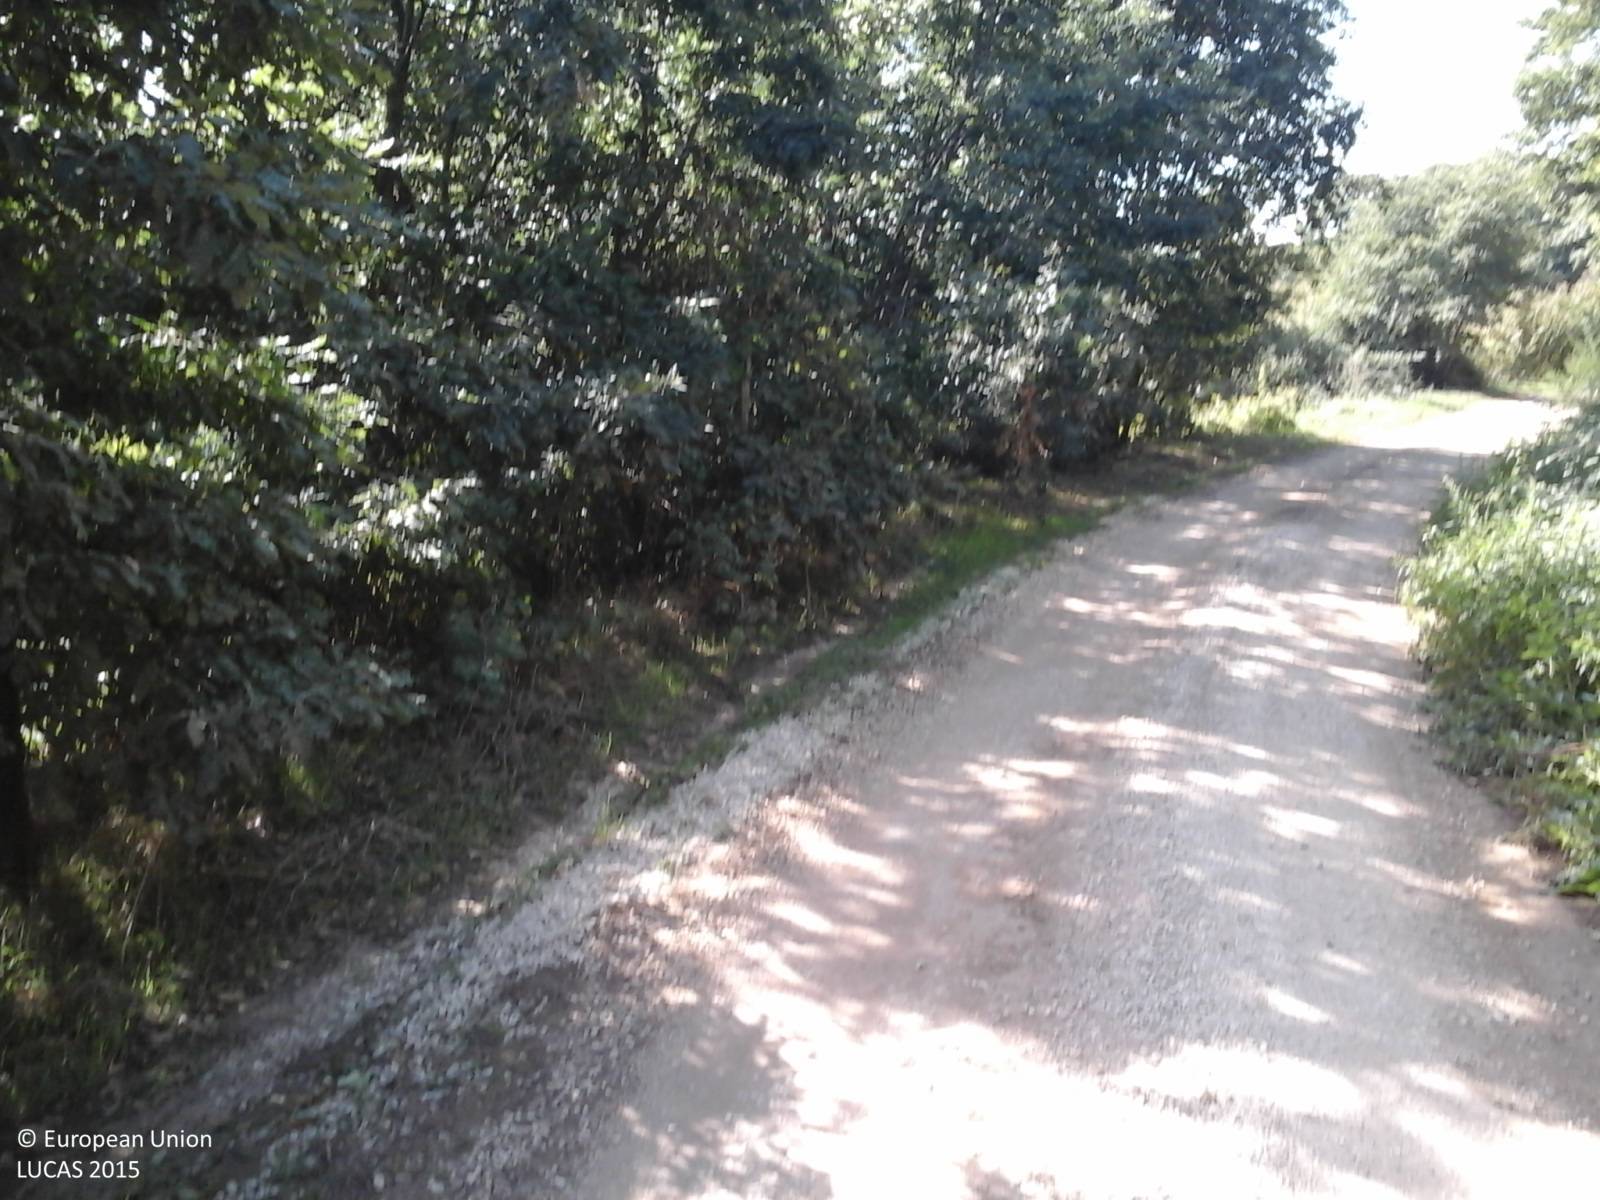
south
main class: Woodland
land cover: Broadleaved woodland
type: thermophilous deciduous forest
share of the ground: > 75 %
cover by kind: broadleaved forest trees 75 %, shrubs 25 %
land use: Semi-natural and natural areas not in use
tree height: > 5 m
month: September
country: IT
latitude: 42.3577
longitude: 12.2626
